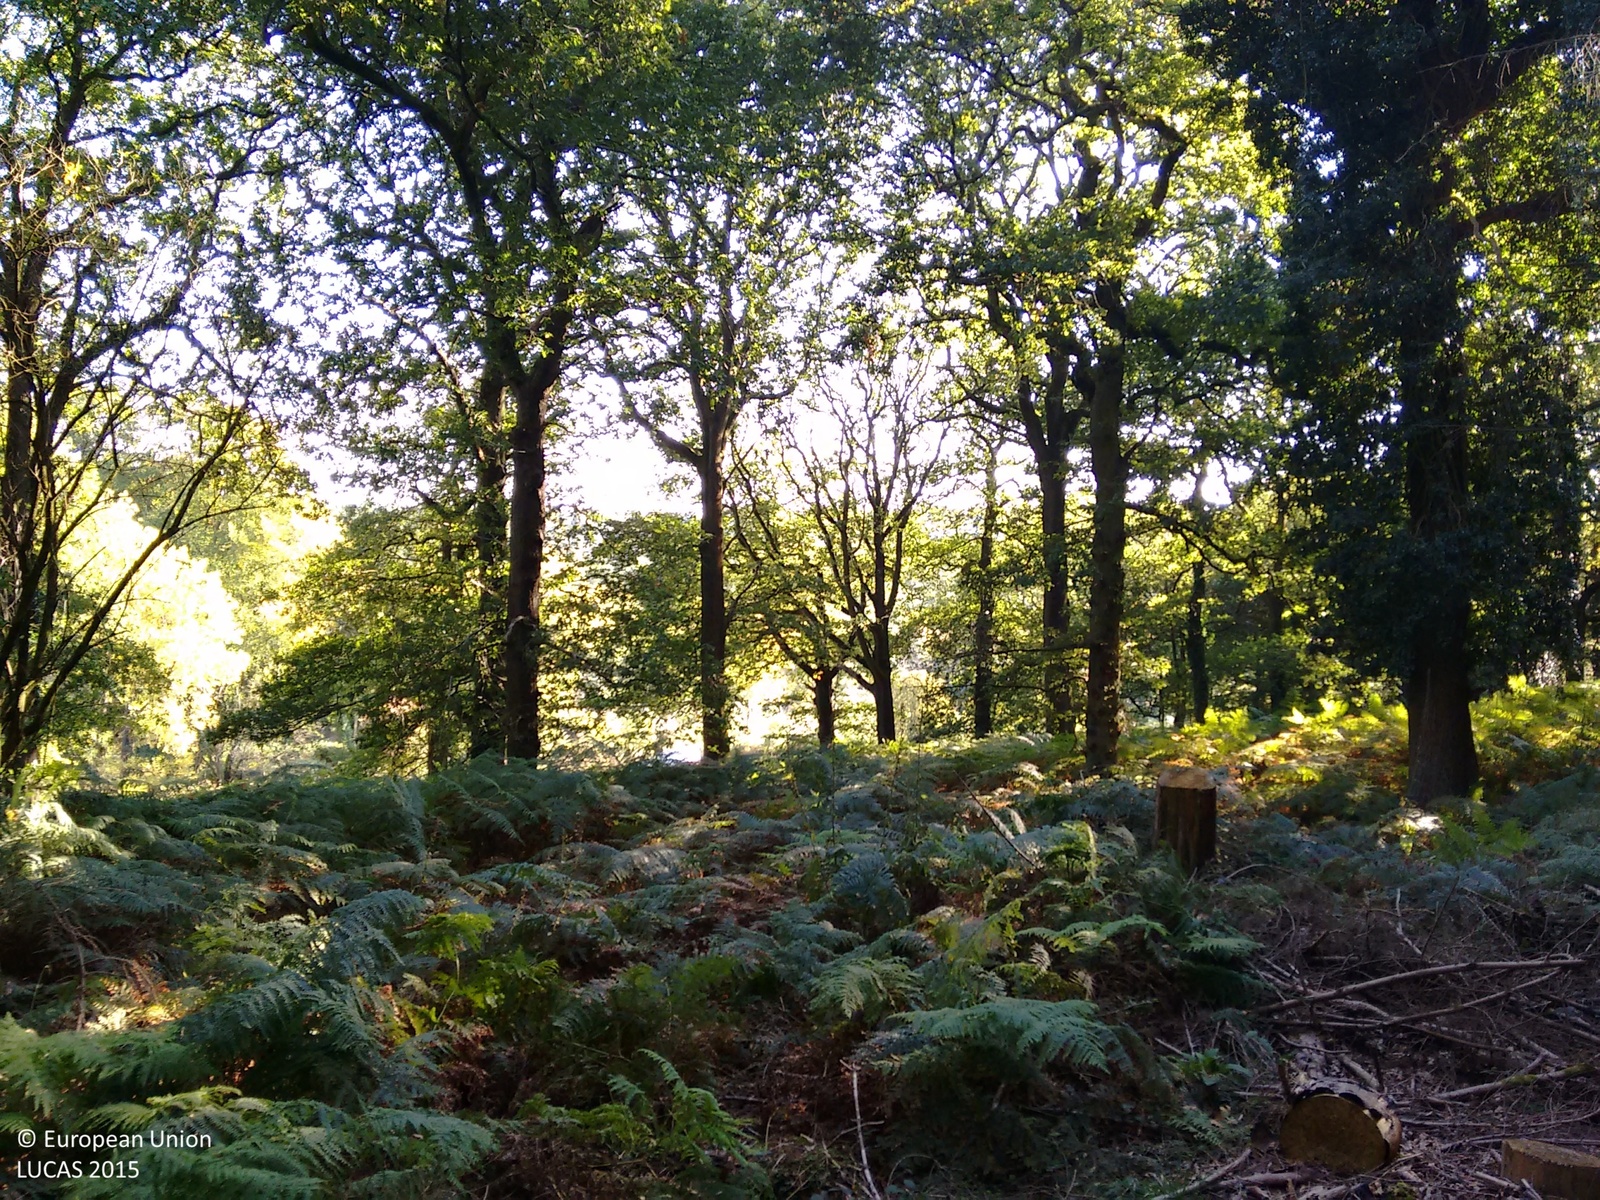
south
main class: Woodland
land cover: Spruce dominated coniferous woodland
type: exotic forest
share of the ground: > 75 %
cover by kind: coniferous forest trees 70 %, herbaceous plants 30 %
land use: Forestry
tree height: > 5 m
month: September
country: GB
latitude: 51.8373
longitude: -2.5338
